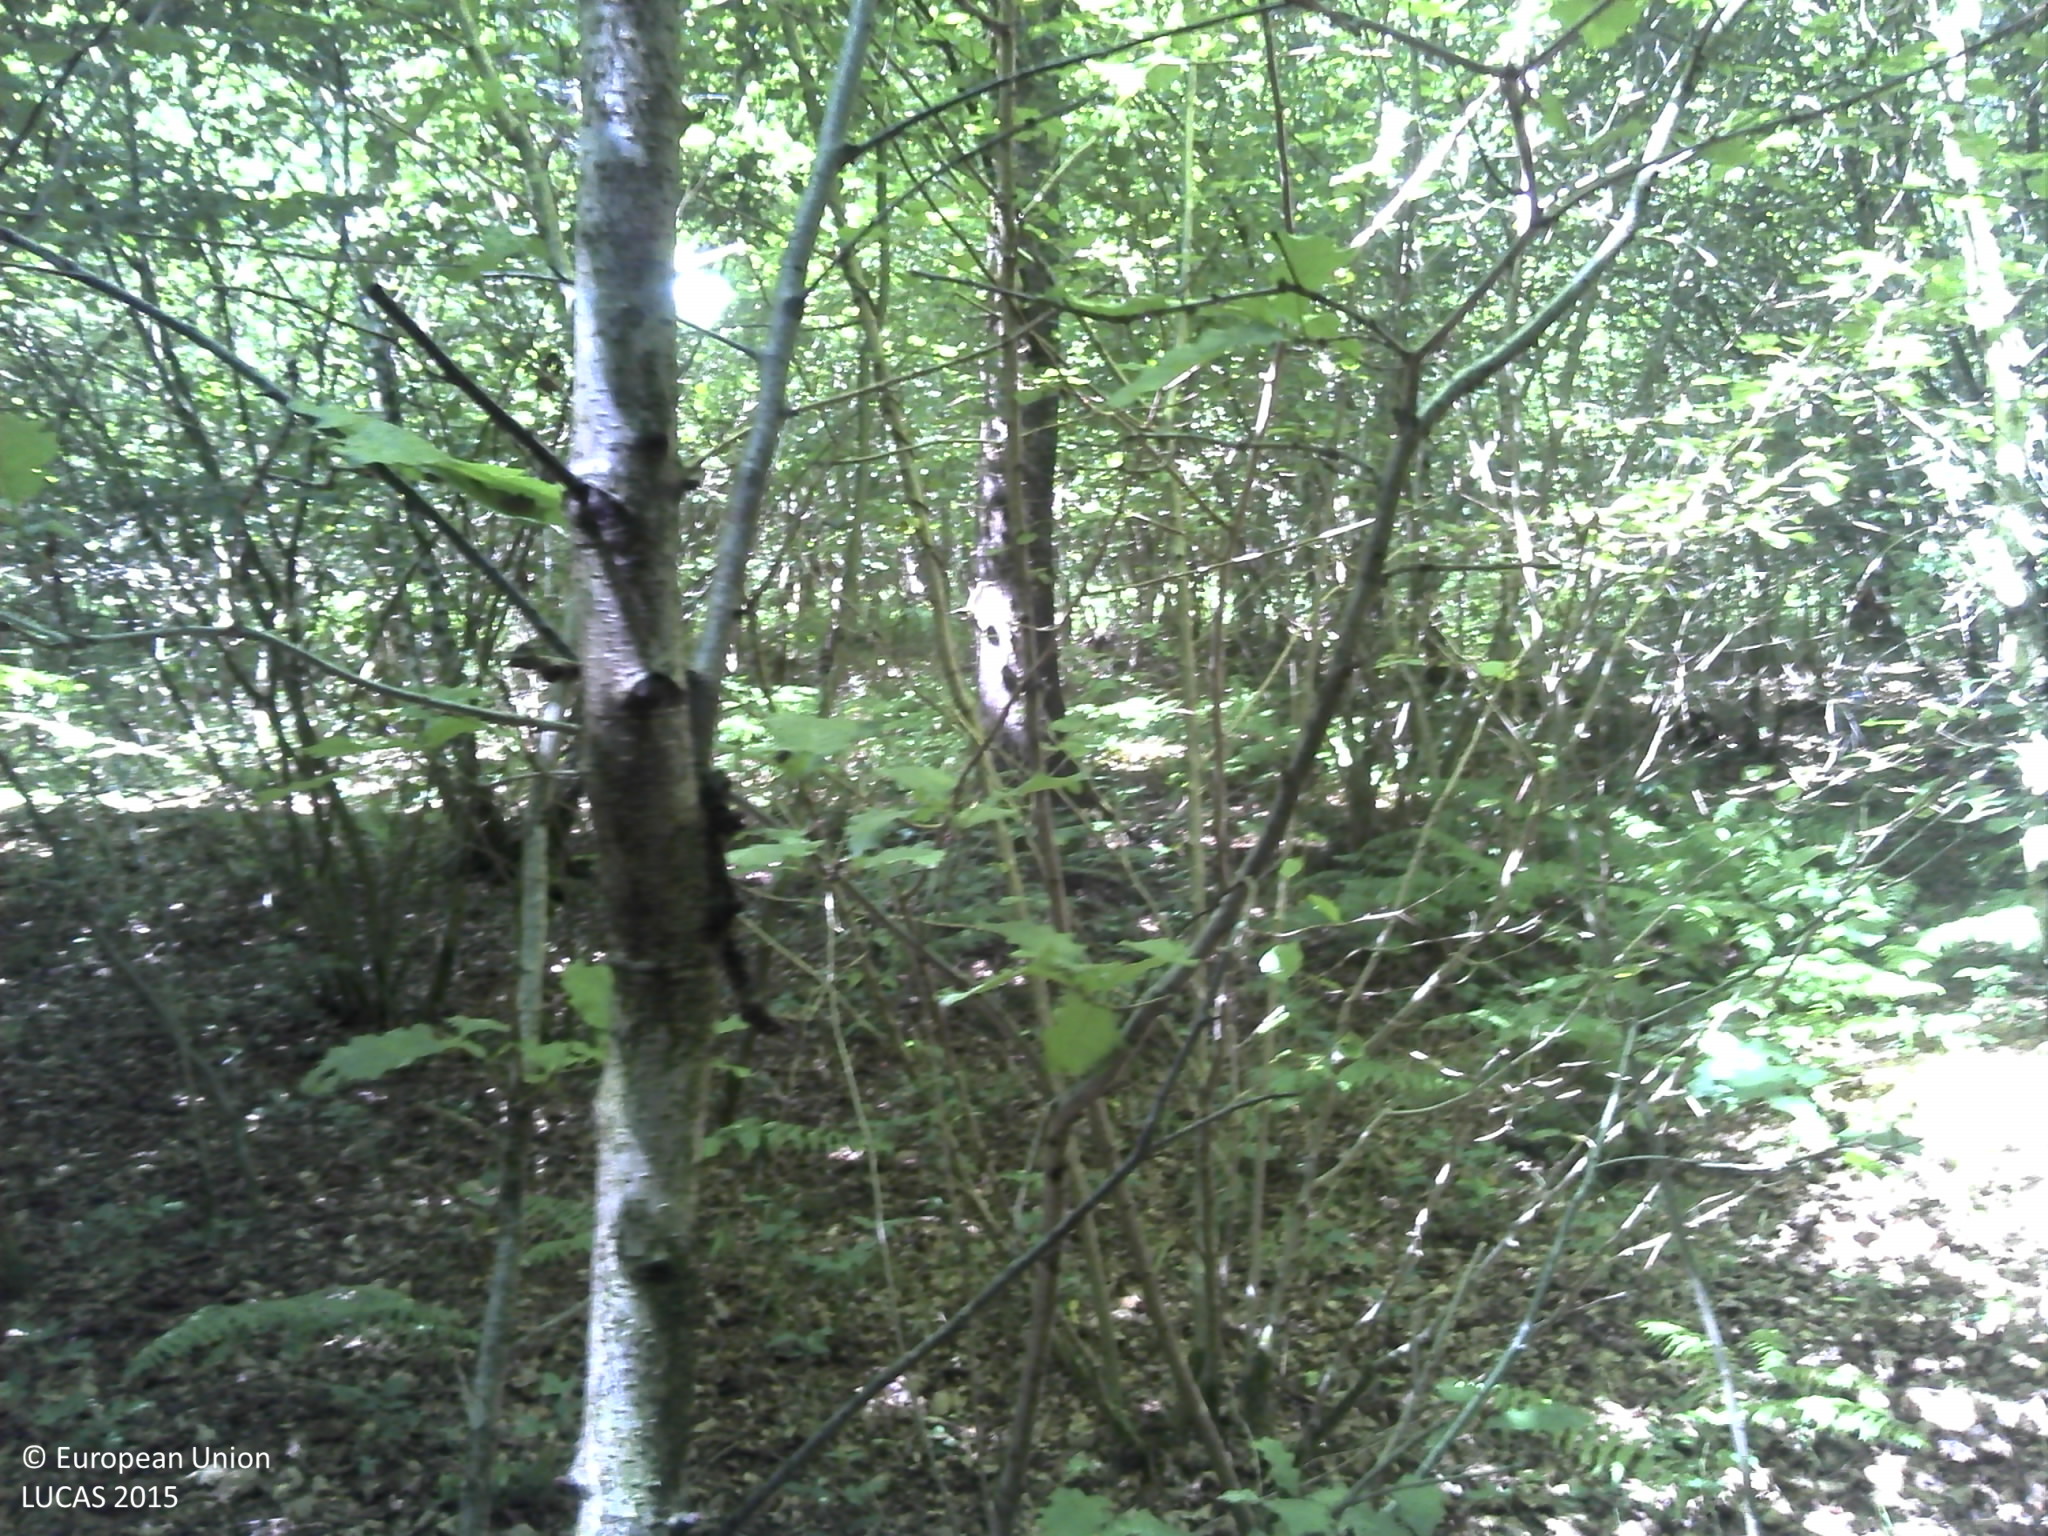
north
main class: Woodland
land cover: Broadleaved woodland
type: acidophilous oak and oak-birch forest
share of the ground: > 75 %
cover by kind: broadleaved forest trees 70 %, herbaceous plants 15 %, consolidated bare surface 10 %, lichens and mosses 5 %
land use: Forestry
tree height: > 5 m
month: June
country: FR
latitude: 50.0291
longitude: 4.7899
